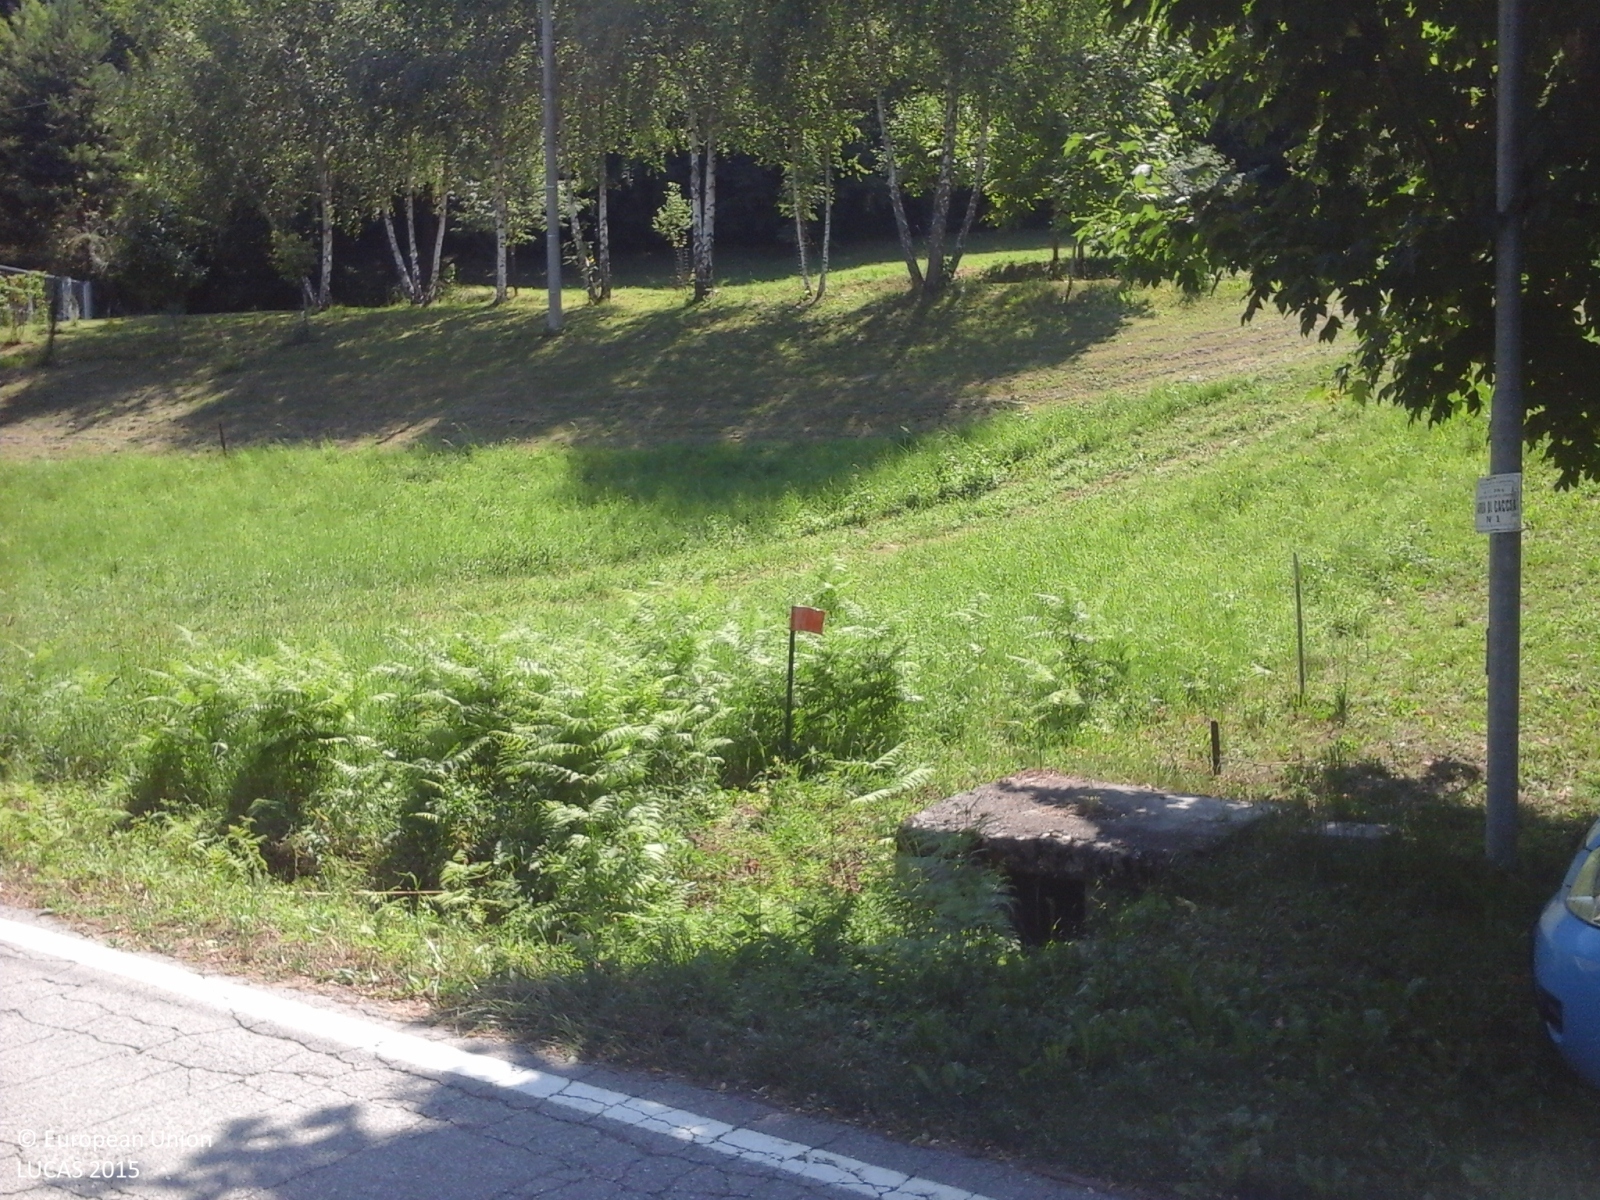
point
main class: Grassland
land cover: Grassland without tree/shrub cover
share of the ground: > 75 %
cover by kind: herbaceous plants 100 %
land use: Residential
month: June
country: IT
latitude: 44.5304
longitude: 10.3139
